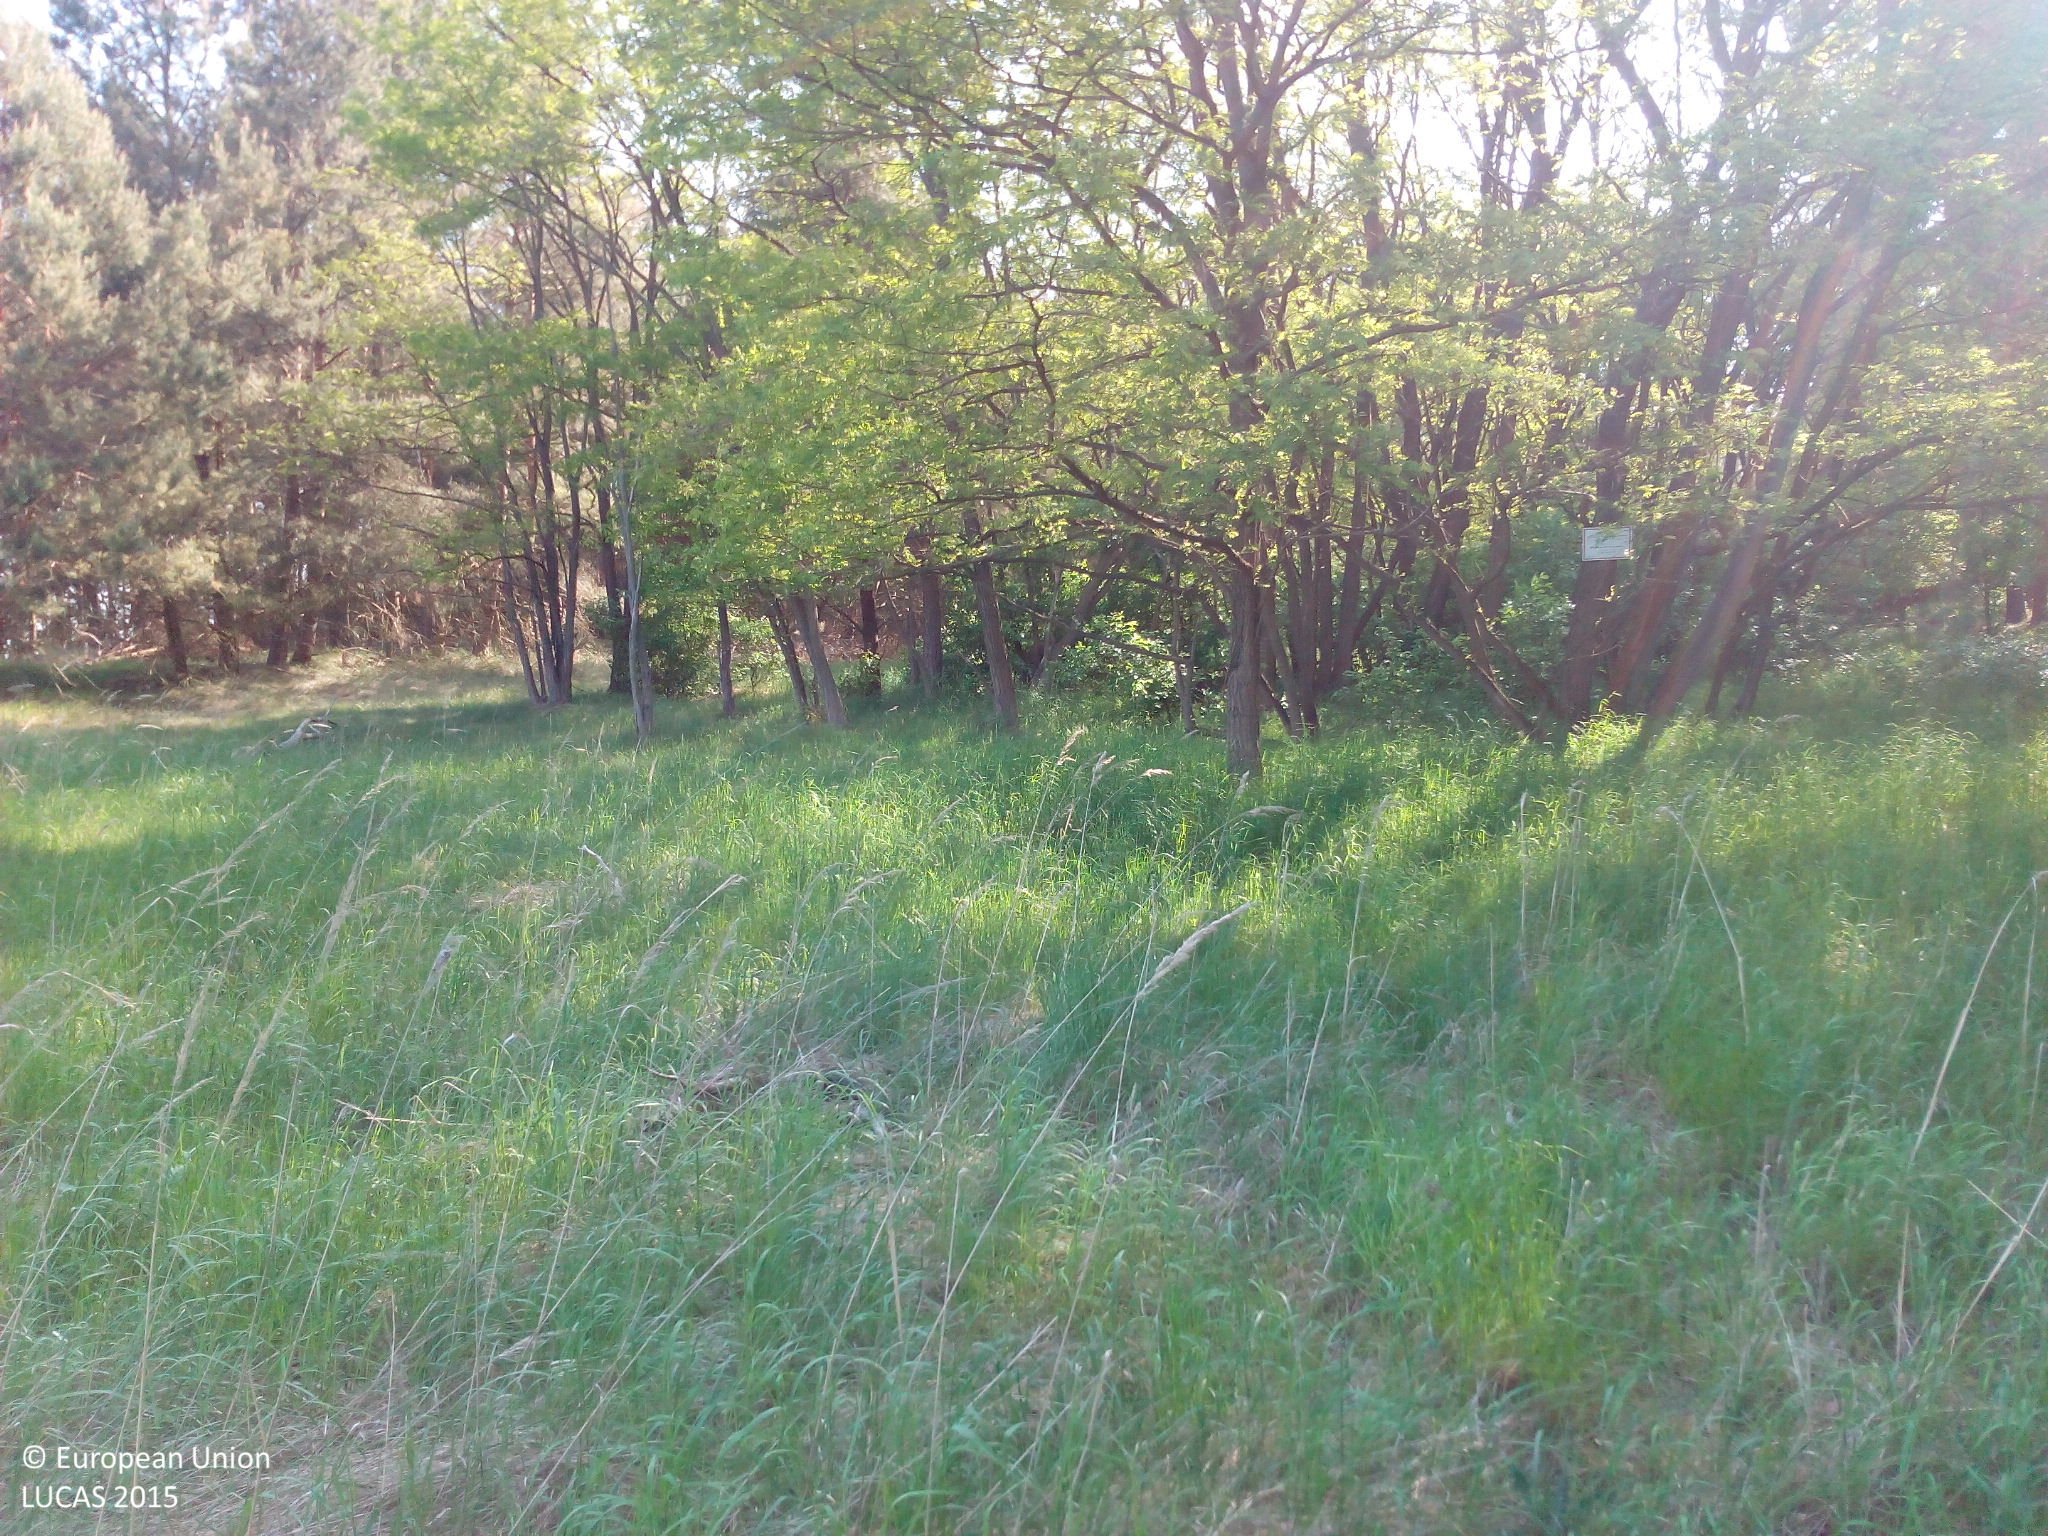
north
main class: Grassland
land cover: Grassland without tree/shrub cover
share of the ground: > 75 %
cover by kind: herbaceous plants 100 %
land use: Agriculture (excluding fallow land and kitchen gardens)
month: May
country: DE
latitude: 52.0303
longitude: 13.1338
